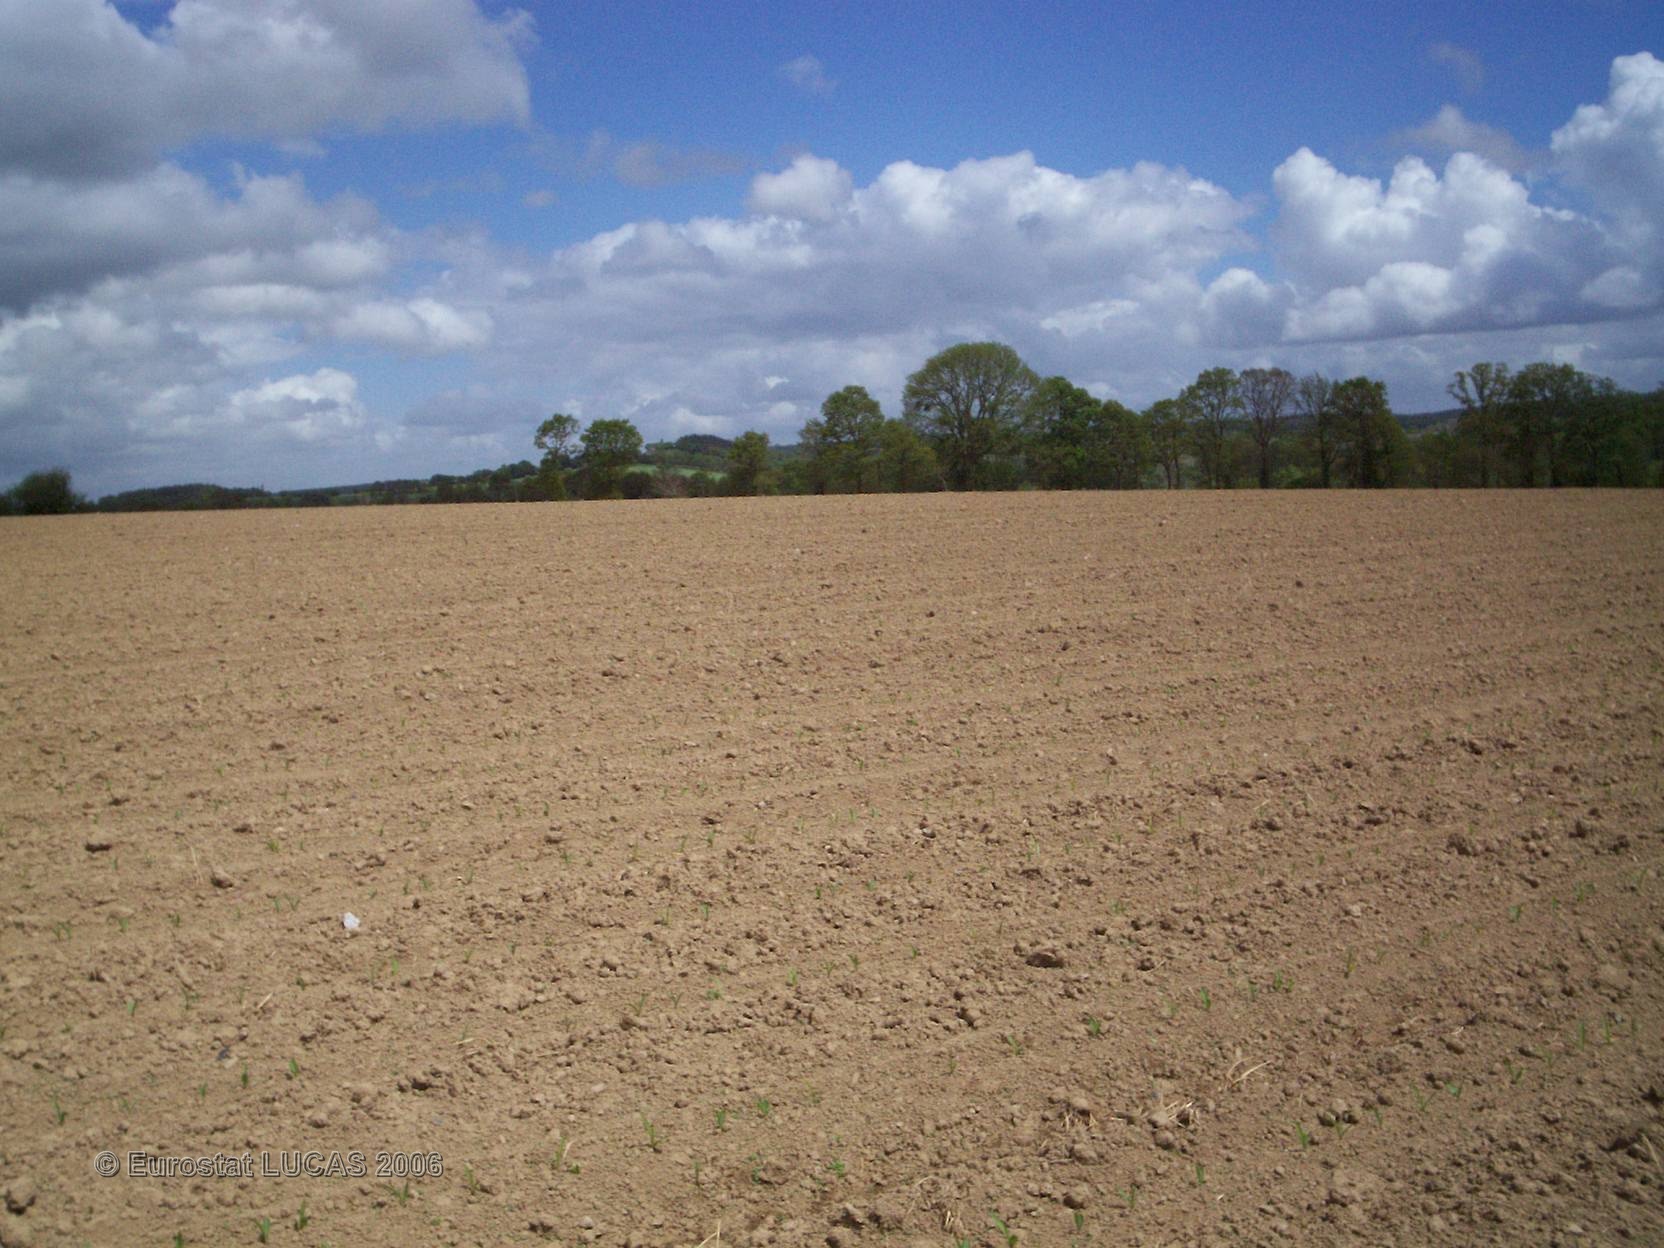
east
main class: Cropland
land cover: Maize
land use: Agriculture (excluding fallow land and kitchen gardens)
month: May
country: FR
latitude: 48.3783
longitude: -2.8528
